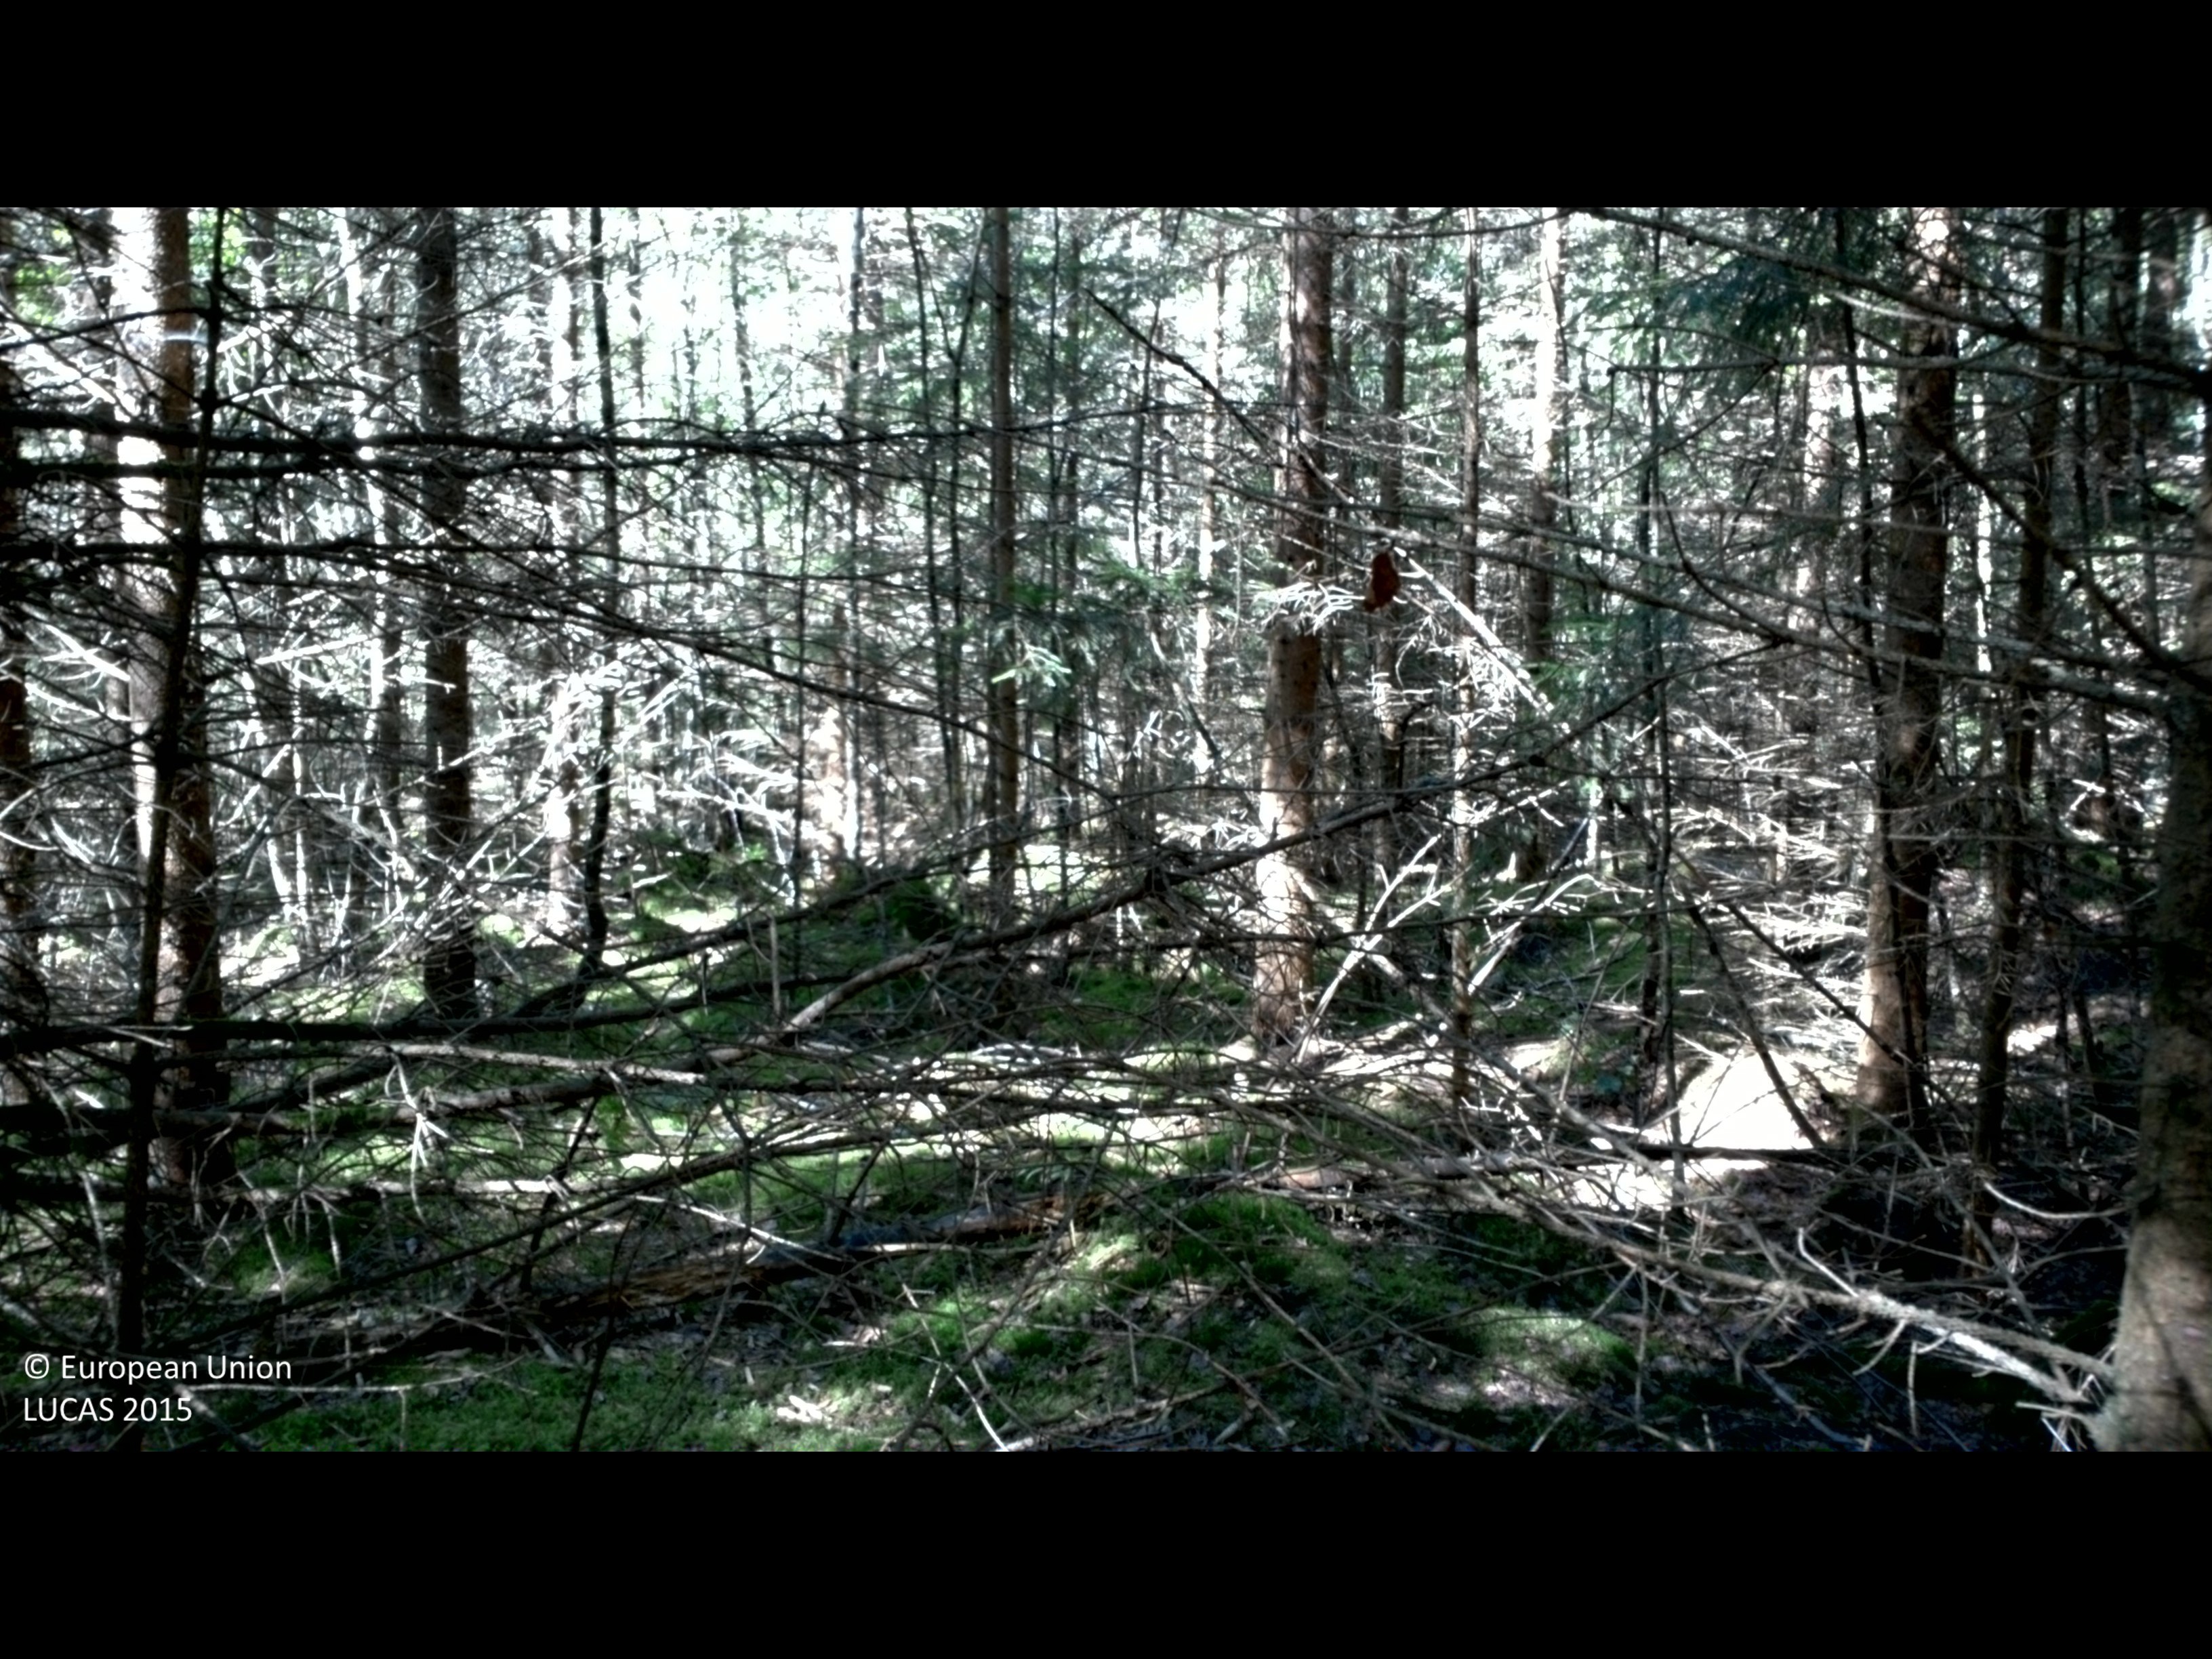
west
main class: Woodland
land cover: Spruce dominated coniferous woodland
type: boreal forest
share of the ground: > 75 %
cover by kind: coniferous forest trees 90 %, lichens and mosses 5 %, unconsolidated bare surface 5 %
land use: Forestry
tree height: > 5 m
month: August
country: SE
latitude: 56.3345
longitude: 14.7373
